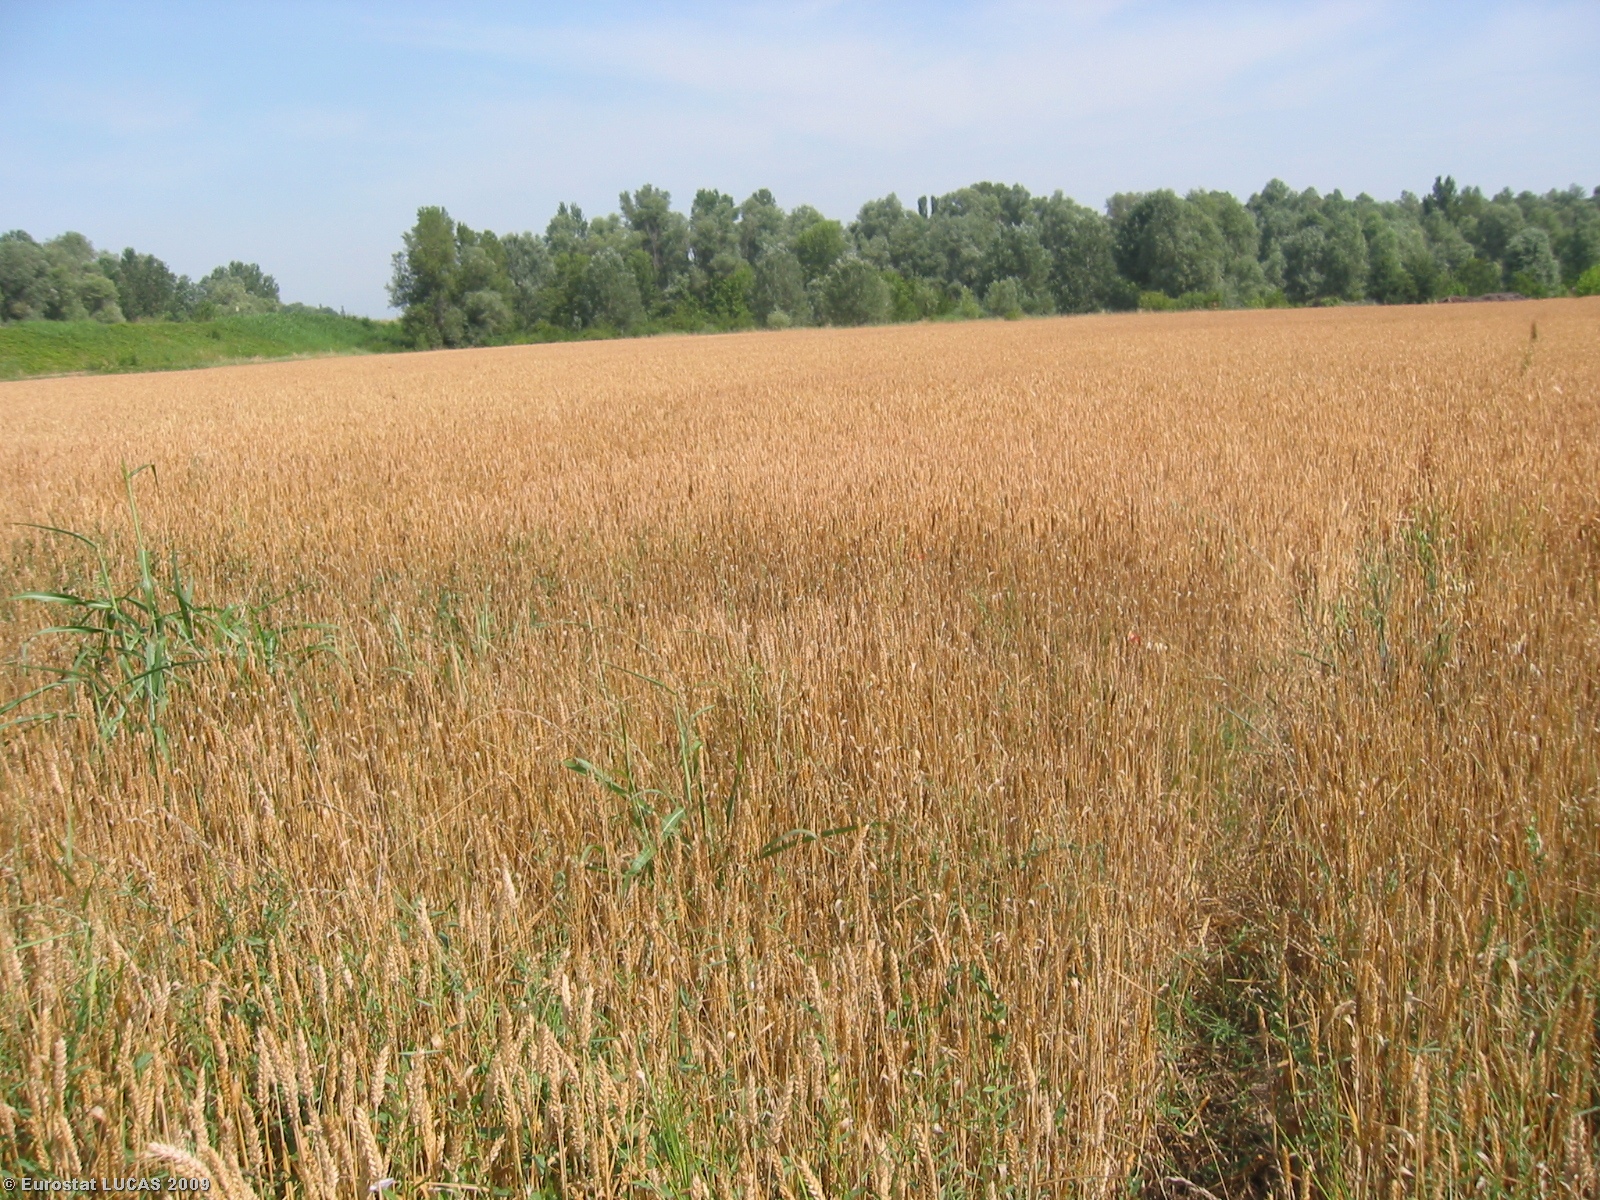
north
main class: Cropland
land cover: Common wheat
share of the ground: > 75 %
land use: Agriculture (excluding fallow land and kitchen gardens)
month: June
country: IT
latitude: 44.6539
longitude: 10.8179
